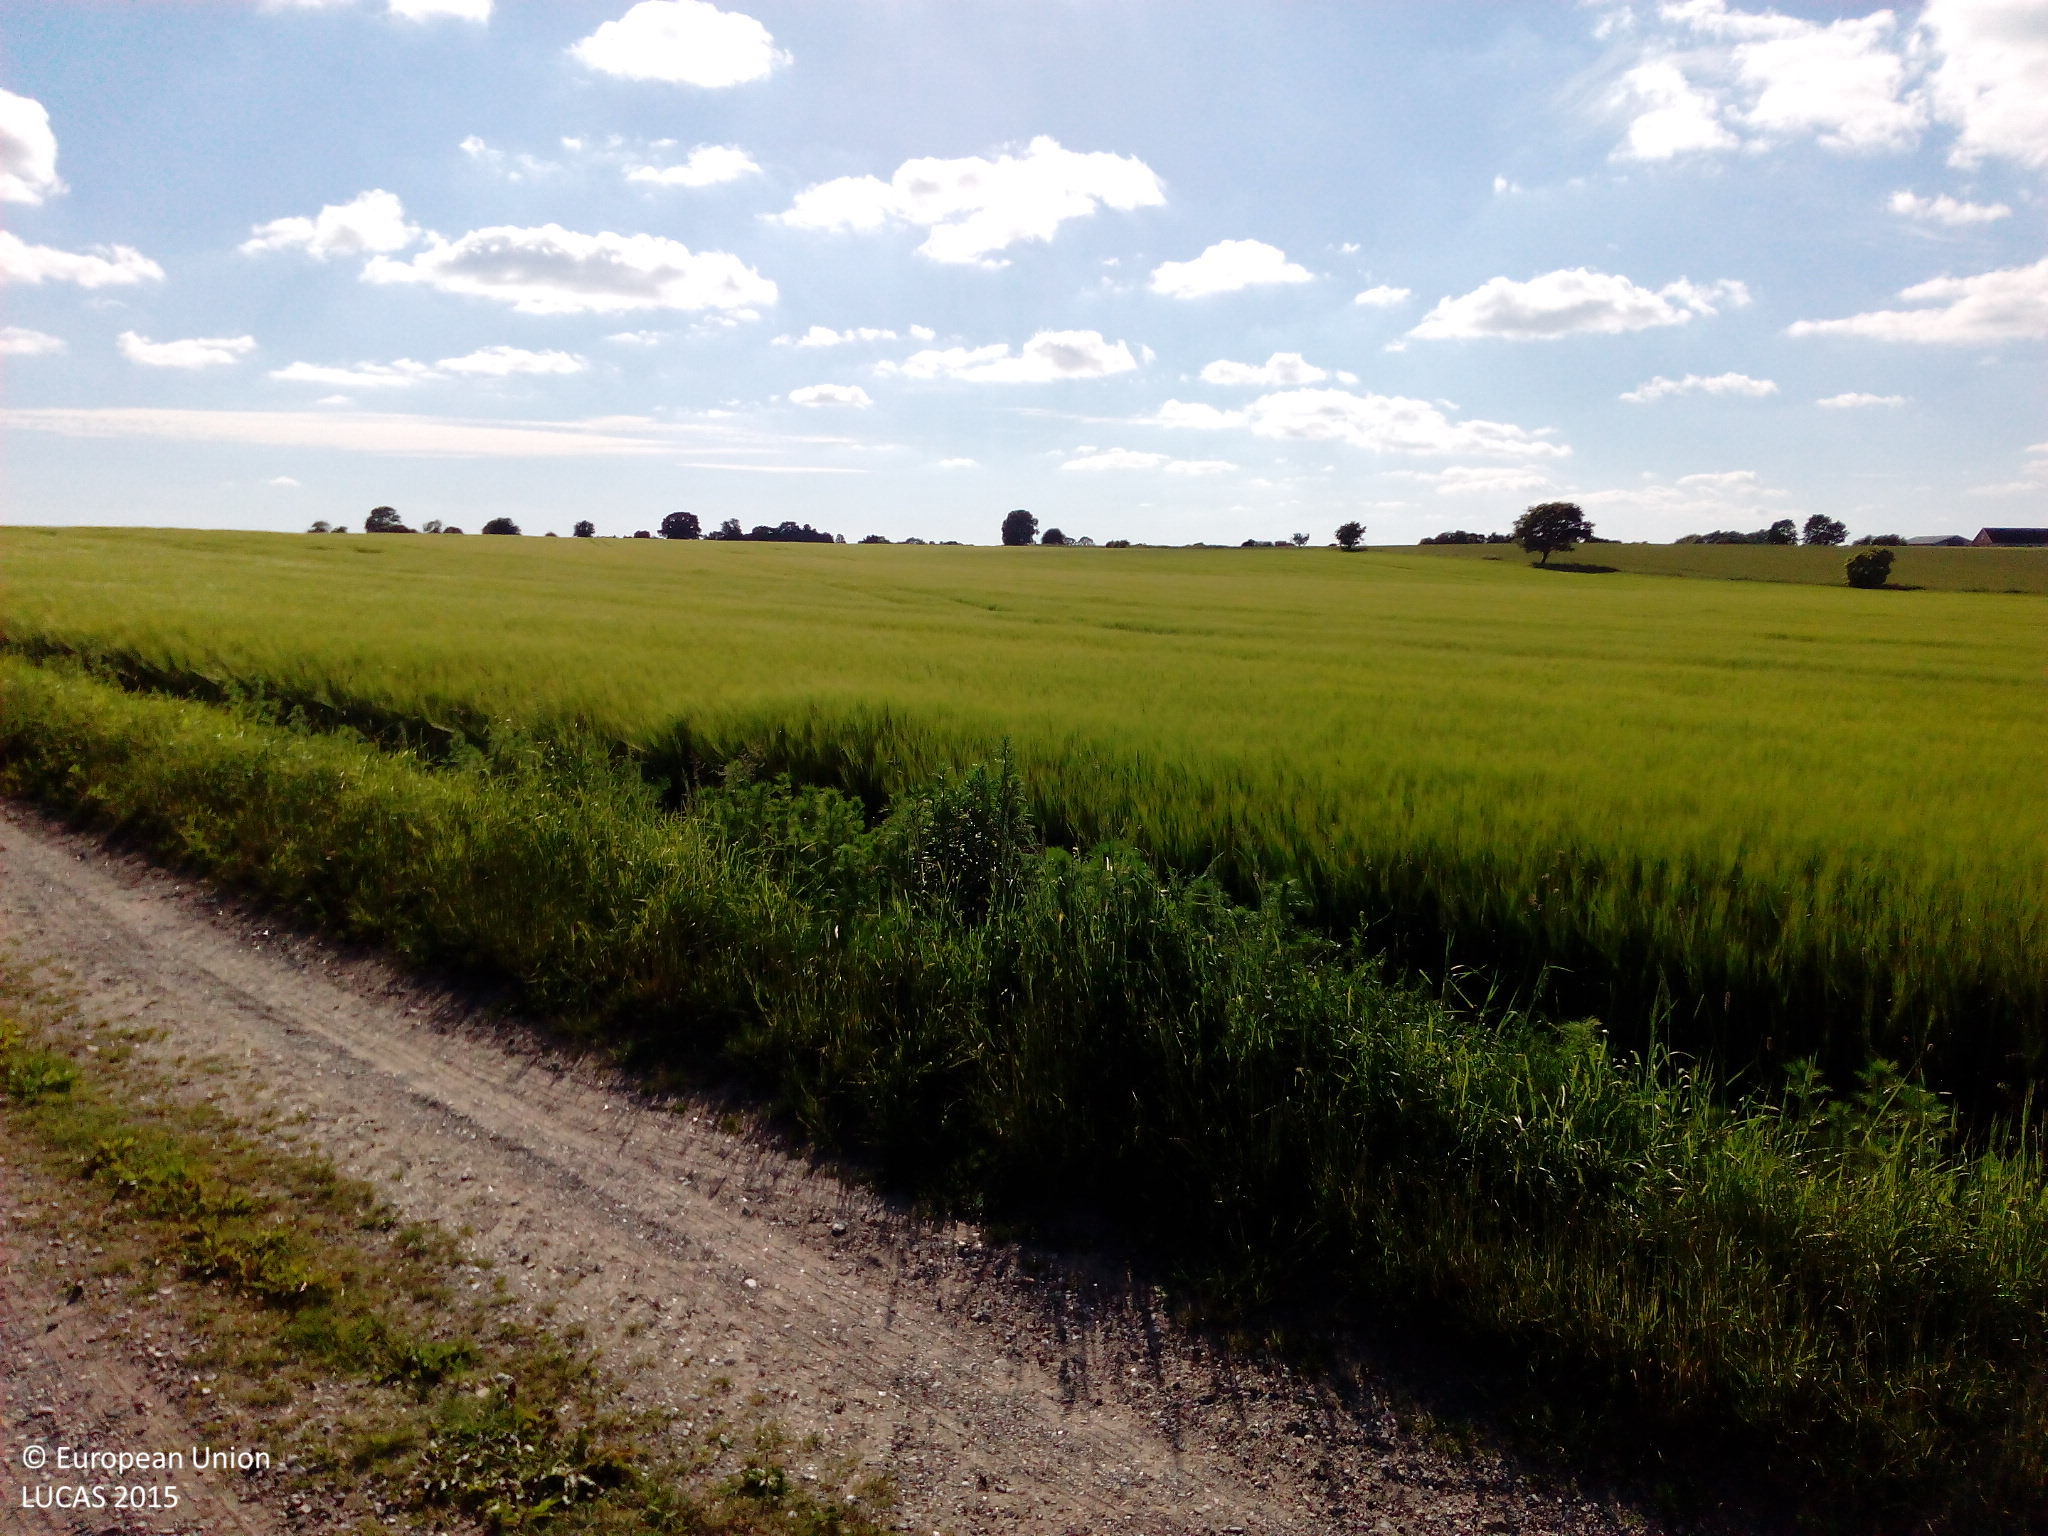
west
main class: Cropland
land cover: Rape and turnip rape
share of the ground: > 75 %
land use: Agriculture (excluding fallow land and kitchen gardens)
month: June
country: DK
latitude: 56.3298
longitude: 10.6623
